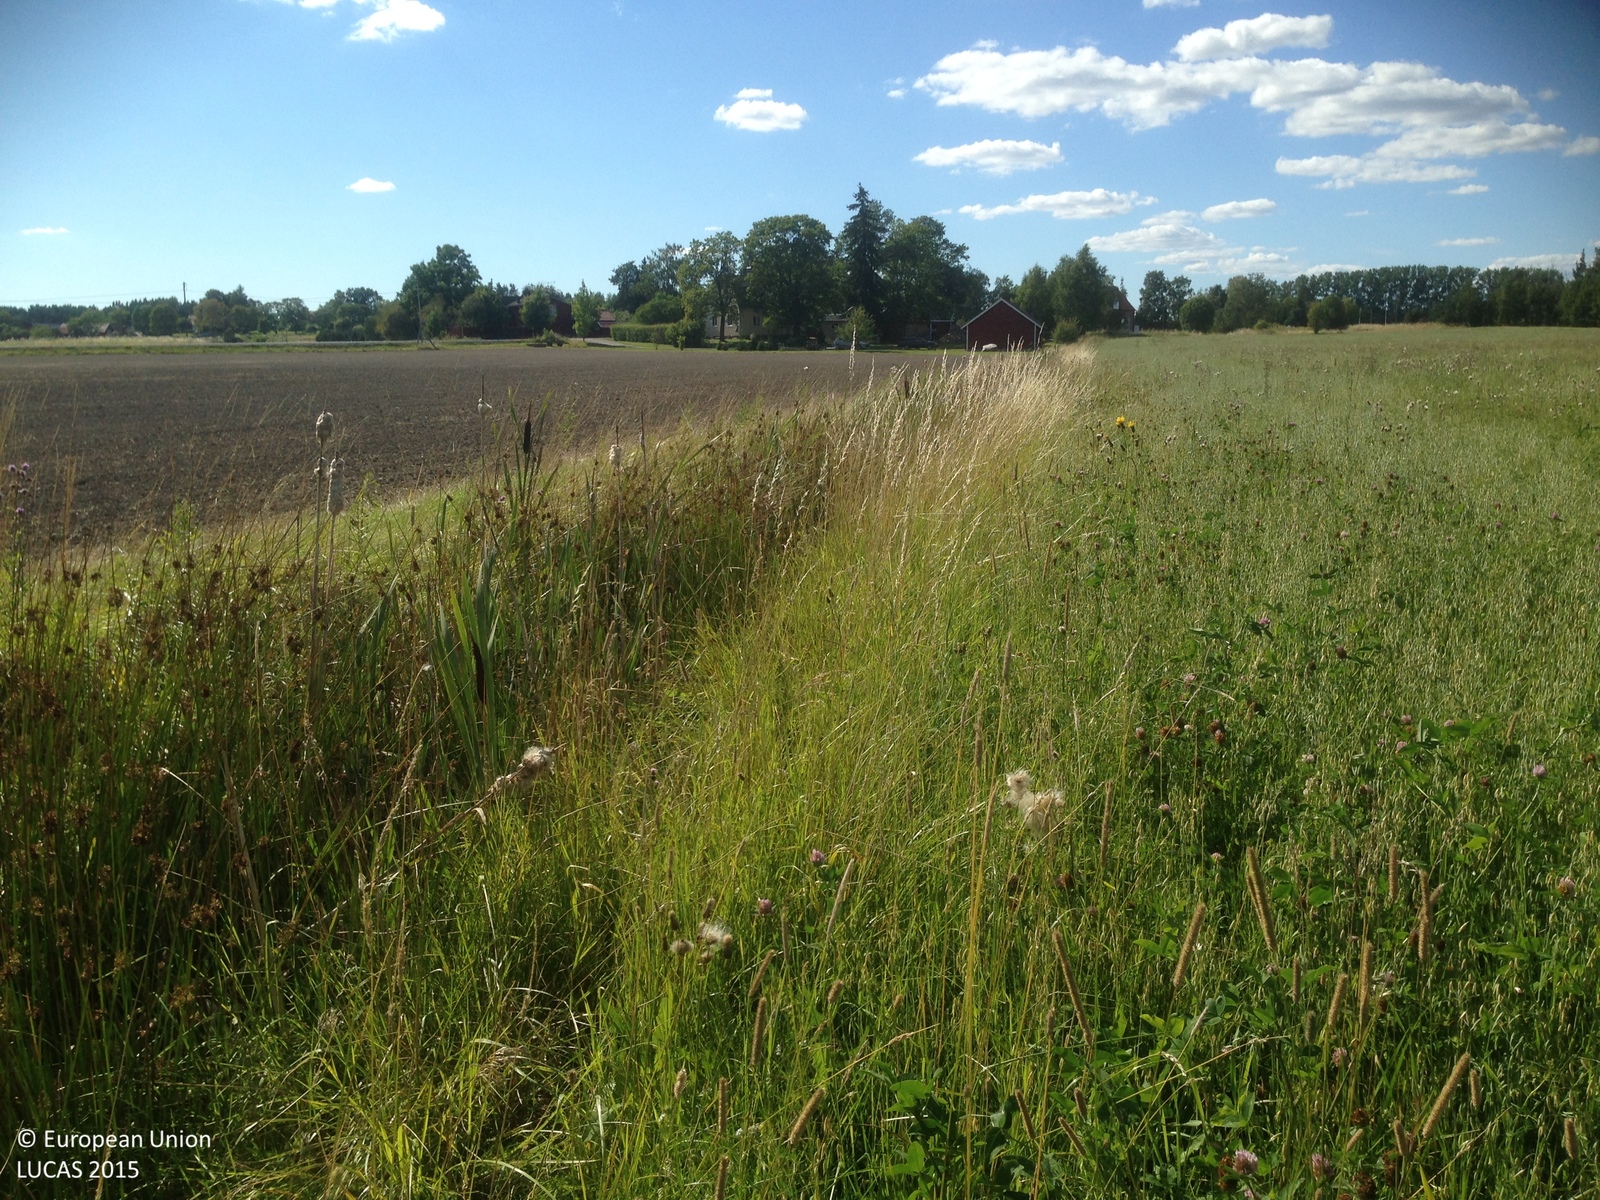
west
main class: Cropland
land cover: Oats
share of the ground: > 75 %
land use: Agriculture (excluding fallow land and kitchen gardens)
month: August
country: SE
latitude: 59.6538
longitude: 17.8573
